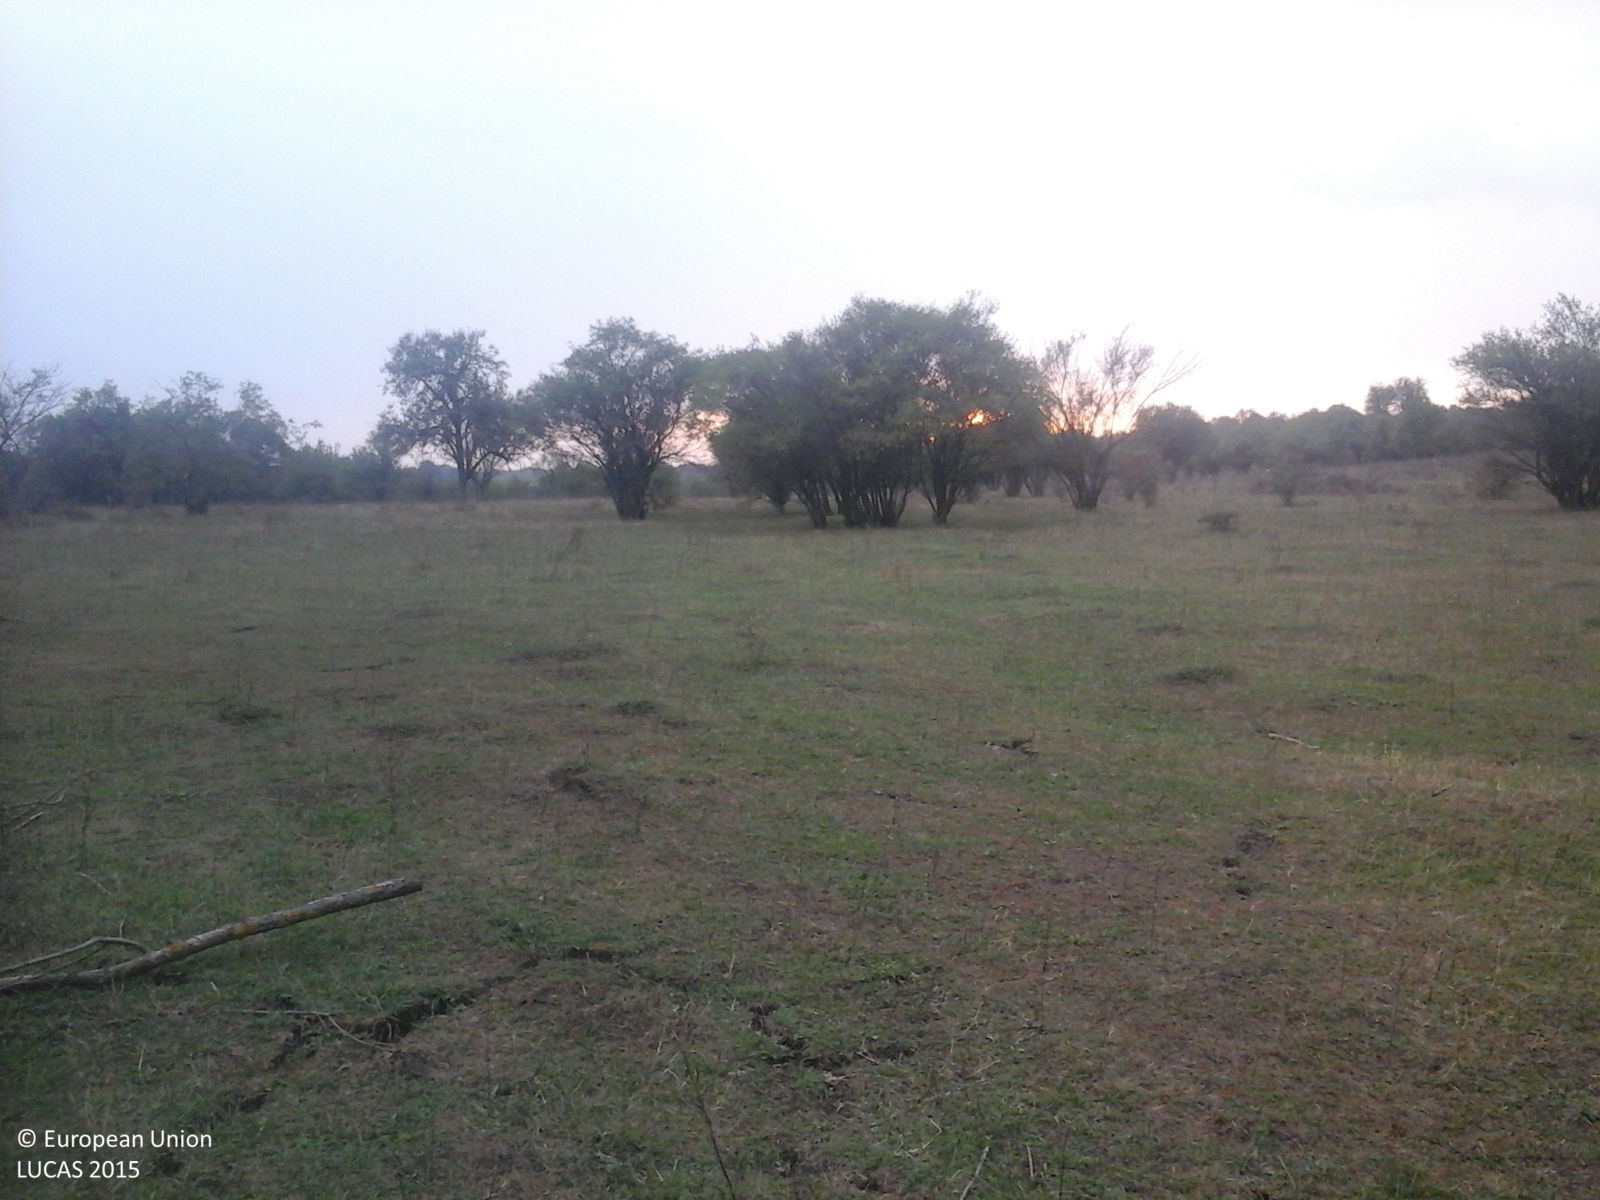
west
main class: Grassland
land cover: Grassland with sparse tree/shrub cover
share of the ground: > 75 %
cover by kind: herbaceous plants 85 %, shrubs 10 %, broadleaved forest trees 5 %
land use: Agriculture (excluding fallow land and kitchen gardens)
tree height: < 5 m
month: September
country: RO
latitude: 45.7961
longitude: 22.9580
